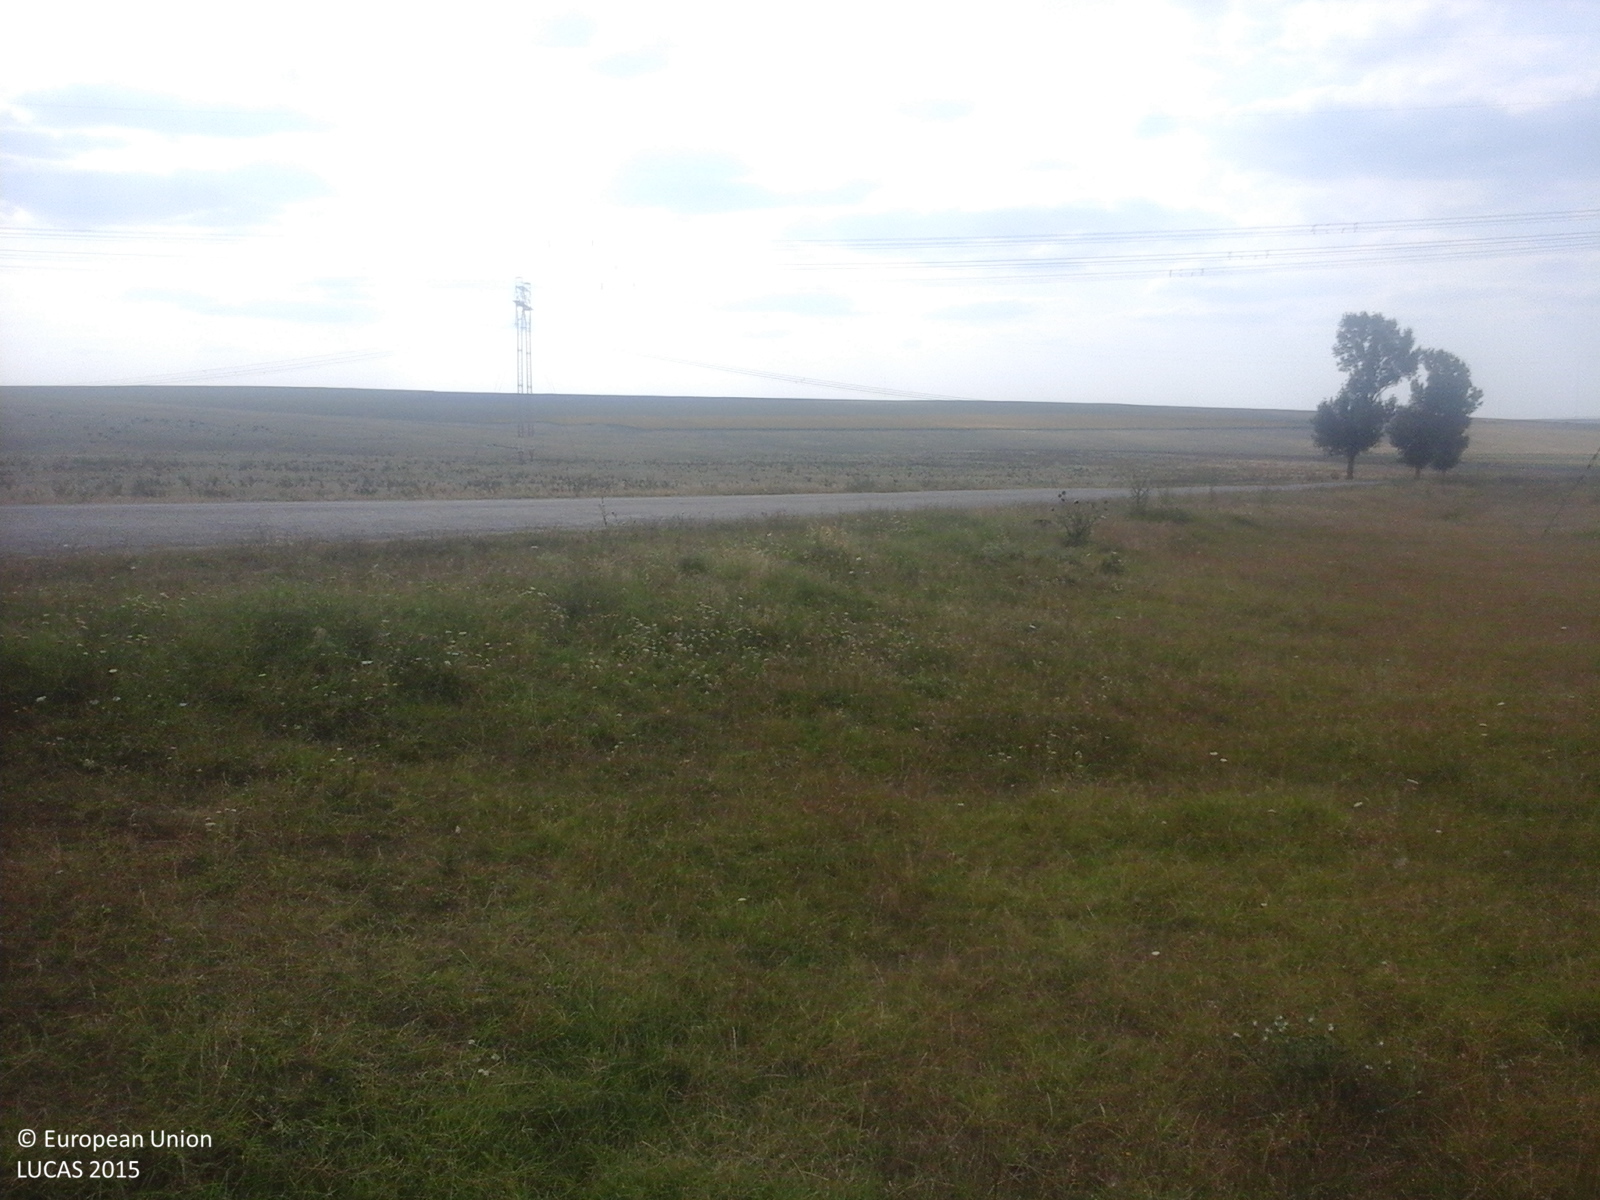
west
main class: Grassland
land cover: Grassland without tree/shrub cover
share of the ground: > 75 %
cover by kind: herbaceous plants 100 %
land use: Agriculture (excluding fallow land and kitchen gardens)
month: August
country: RO
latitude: 44.7117
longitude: 28.2307
